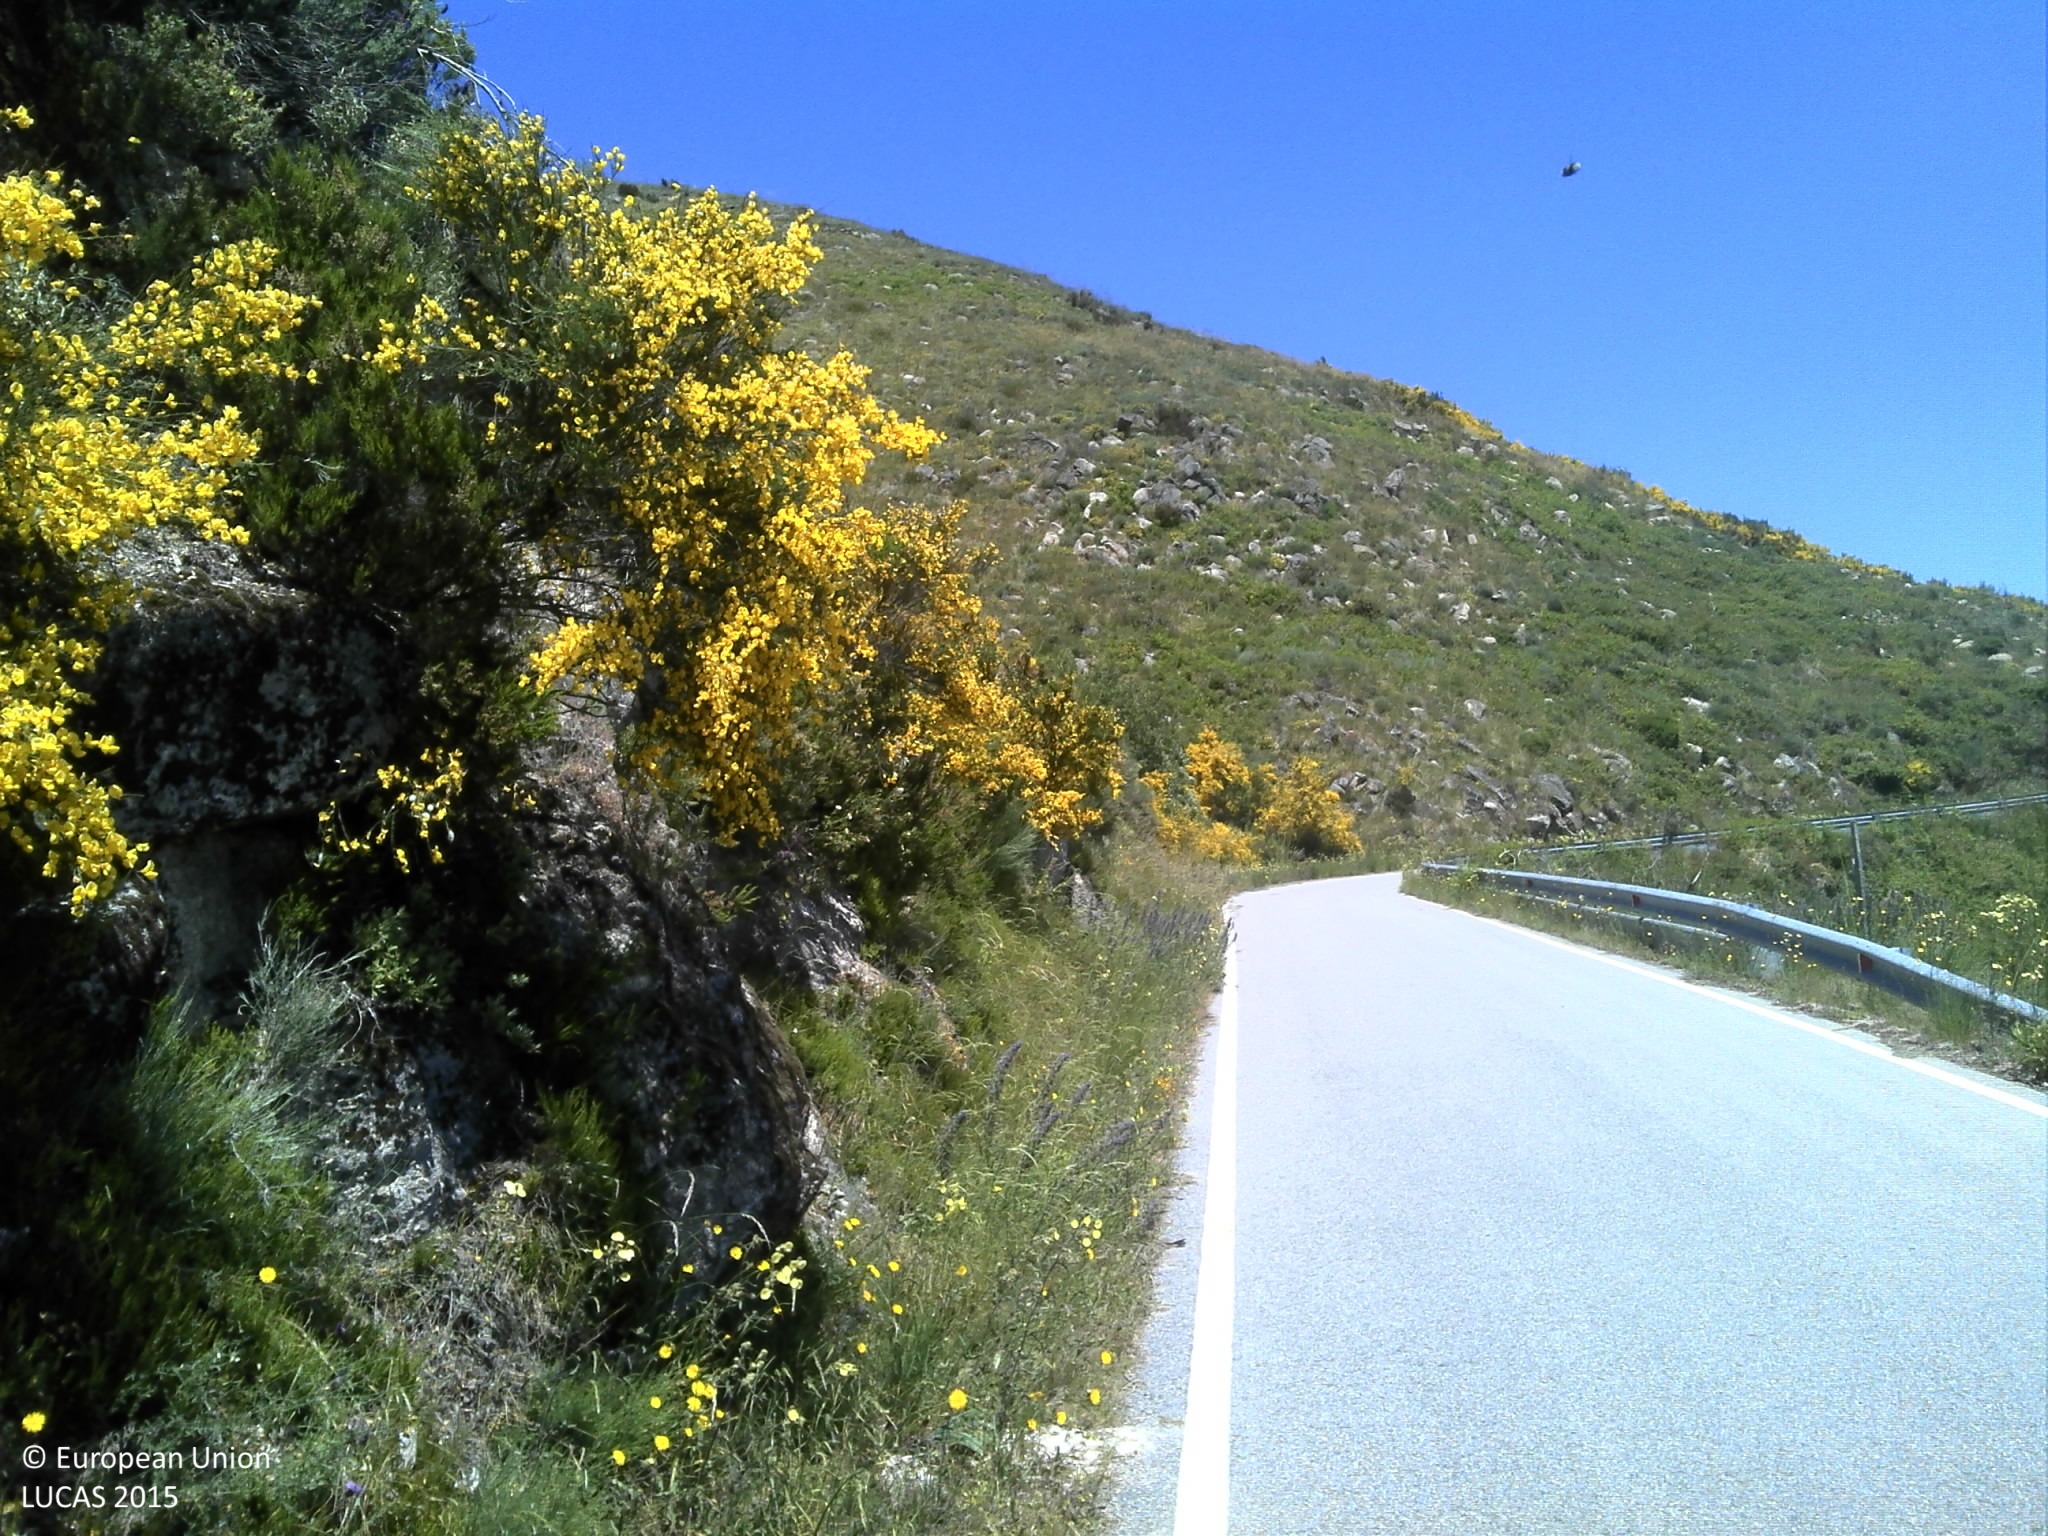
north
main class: Shrubland
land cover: Shrubland without tree cover
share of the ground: 50 - 75 %
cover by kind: shrubs 75 %, unconsolidated bare surface 20 %, herbaceous plants 5 %
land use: Semi-natural and natural areas not in use
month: May
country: PT
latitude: 40.4634
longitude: -7.3364
